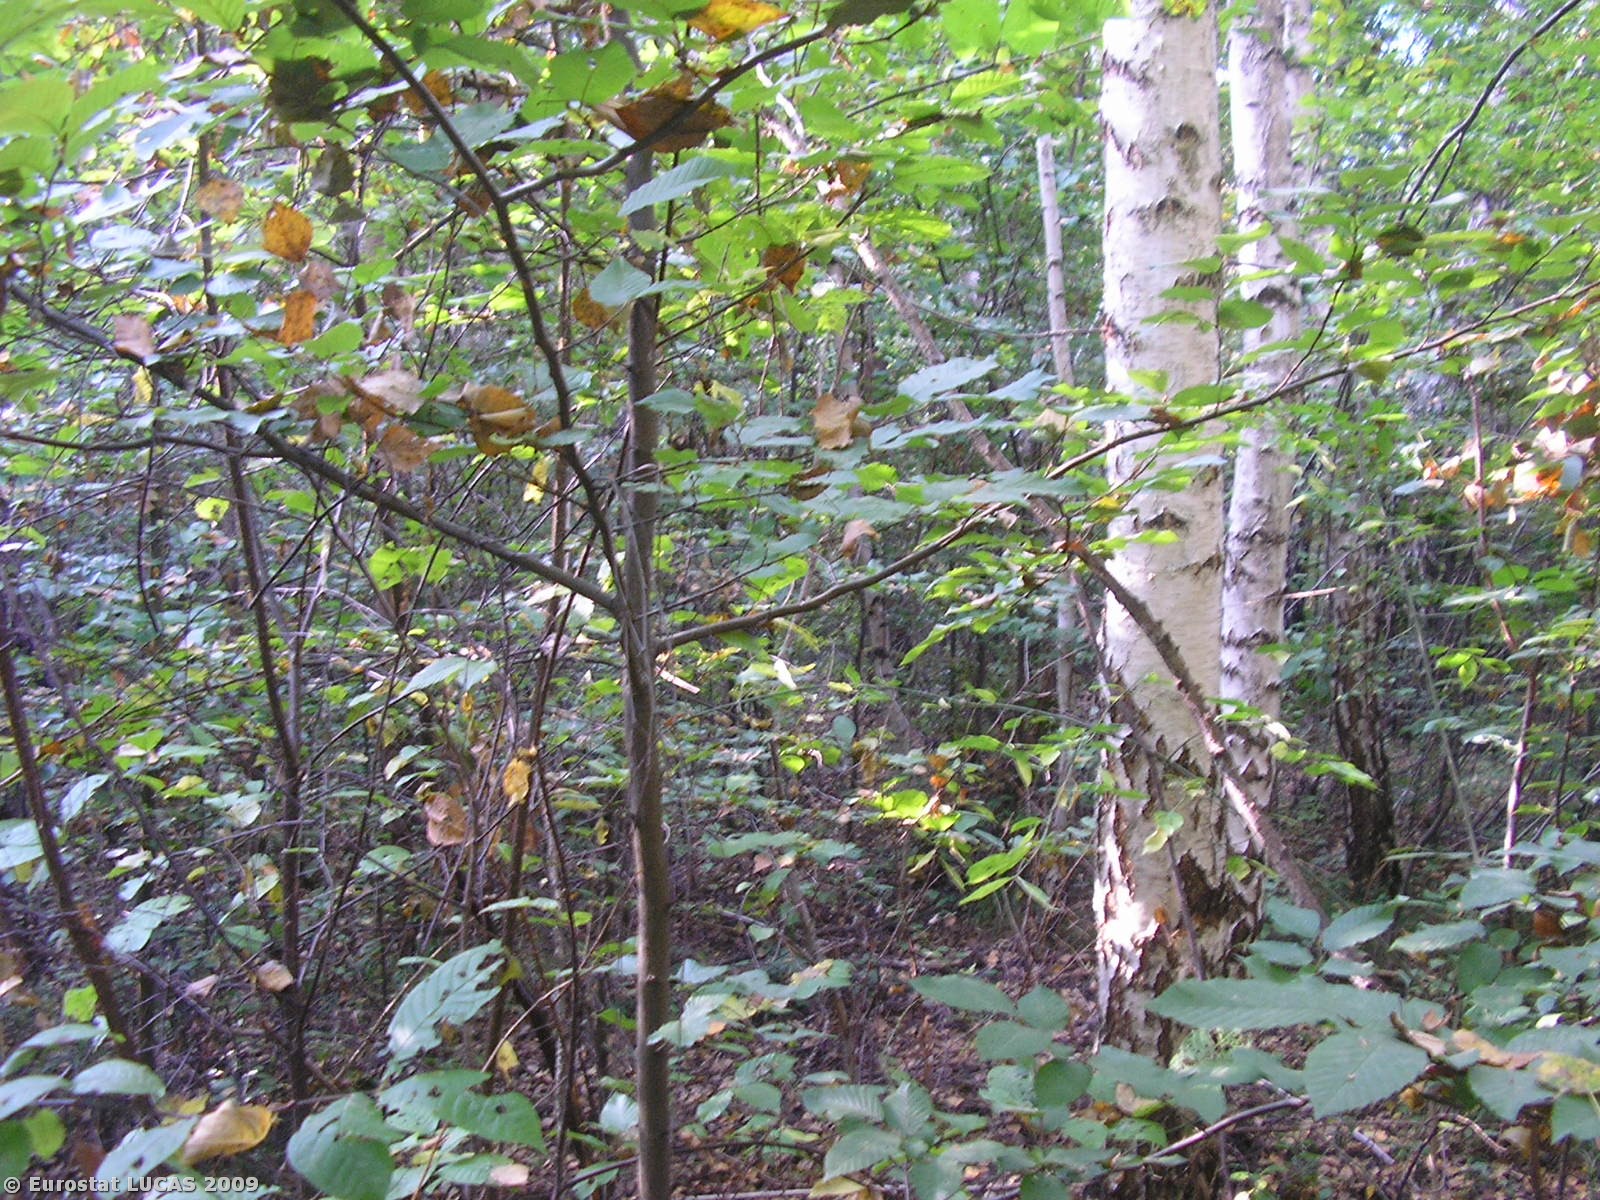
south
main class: Woodland
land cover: Broadleaved woodland
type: non-riverine alder, birch or aspen forest
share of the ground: > 75 %
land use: Forestry
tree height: > 5 m
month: September
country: PL
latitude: 51.9845
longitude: 20.6844
